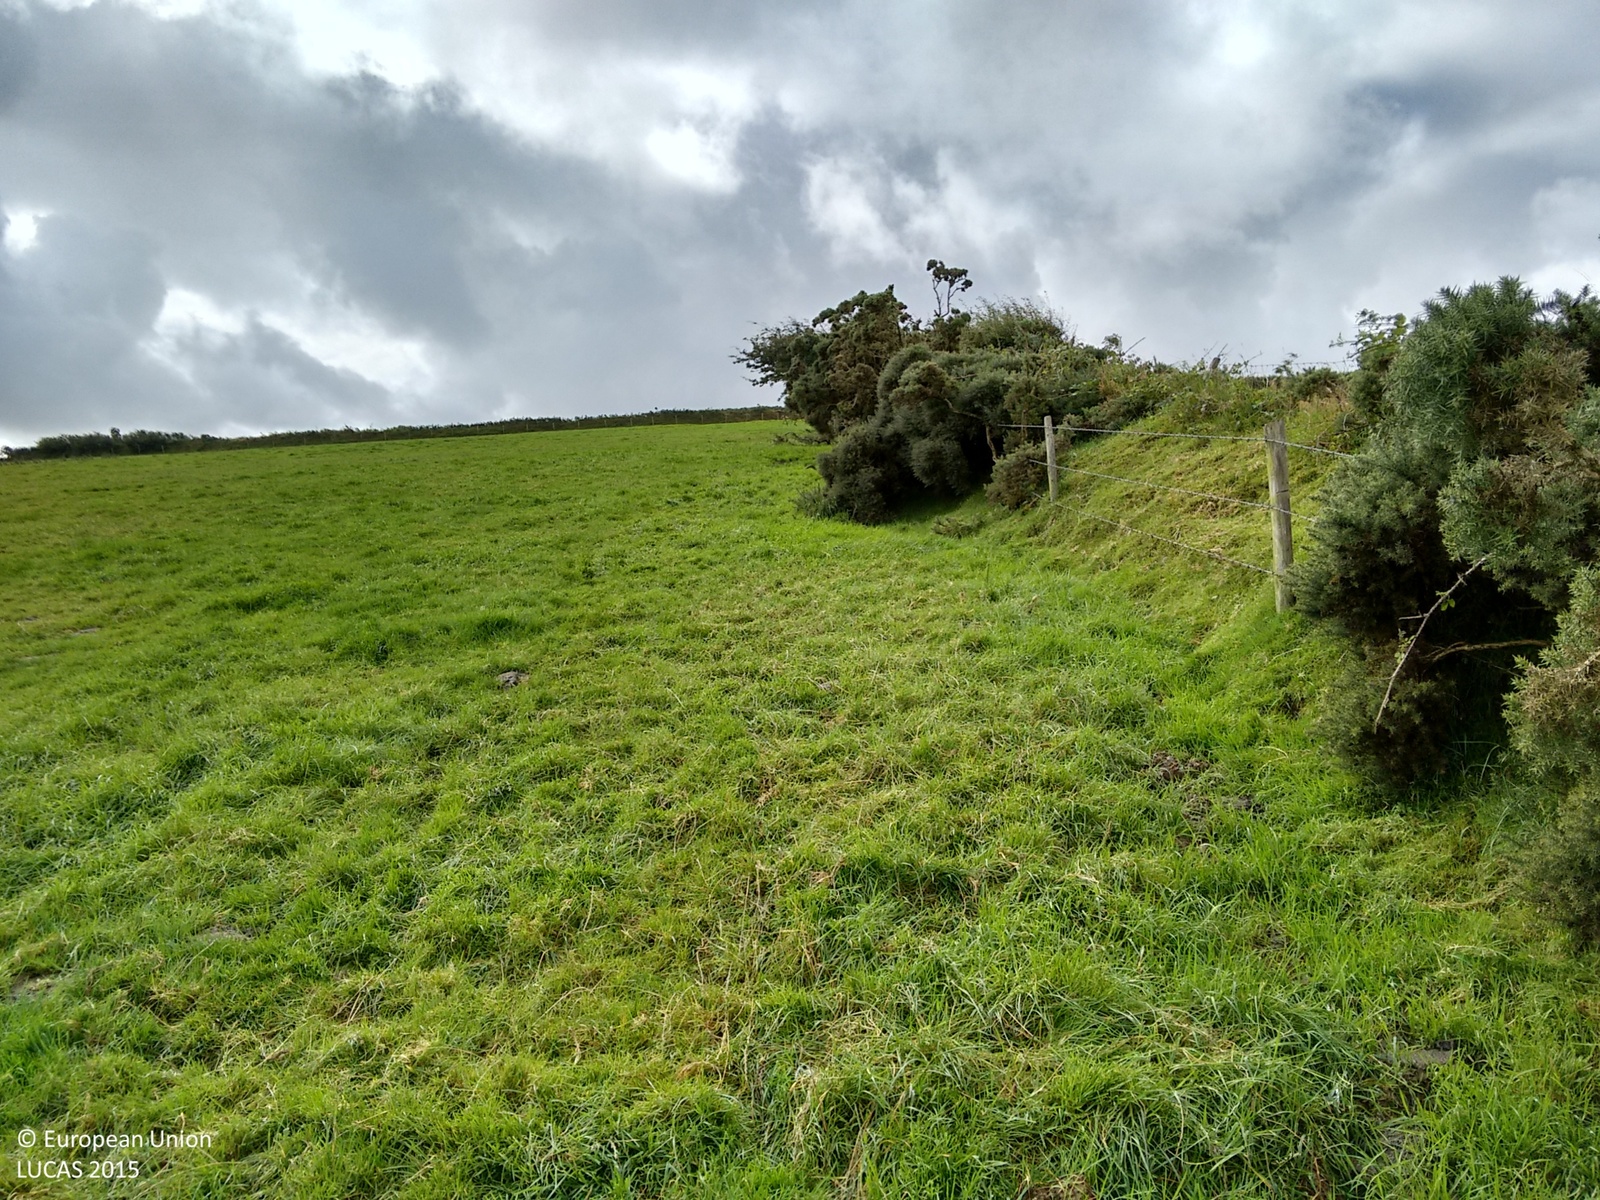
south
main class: Grassland
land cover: Grassland without tree/shrub cover
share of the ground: > 75 %
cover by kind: herbaceous plants 100 %
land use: Agriculture (excluding fallow land and kitchen gardens)
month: August
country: GB
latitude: 51.9658
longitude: -4.8577
